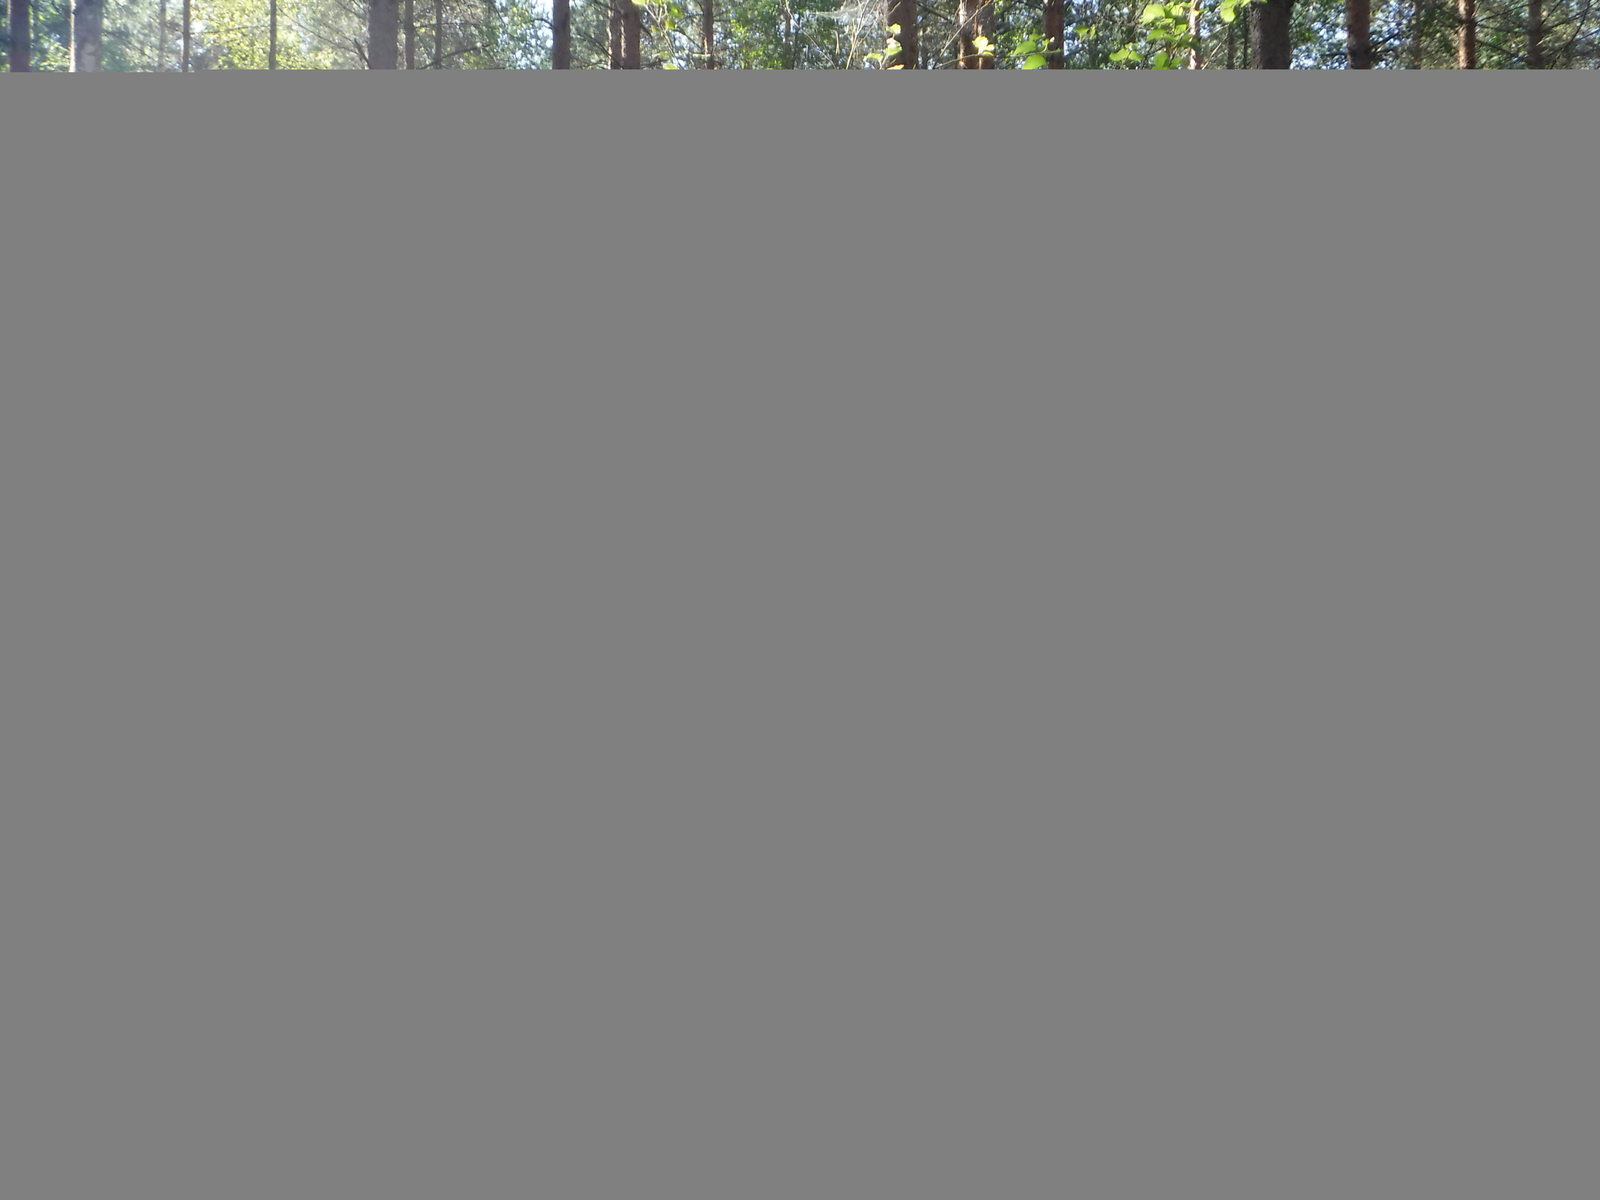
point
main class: Woodland
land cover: Pine dominated mixed woodland
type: boreal forest
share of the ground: 50 - 75 %
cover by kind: coniferous forest trees 40 %, broadleaved forest trees 30 %, herbaceous plants 25 %, shrubs 5 %
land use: Forestry
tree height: > 5 m
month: August
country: FI
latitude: 61.1984
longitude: 22.8539
